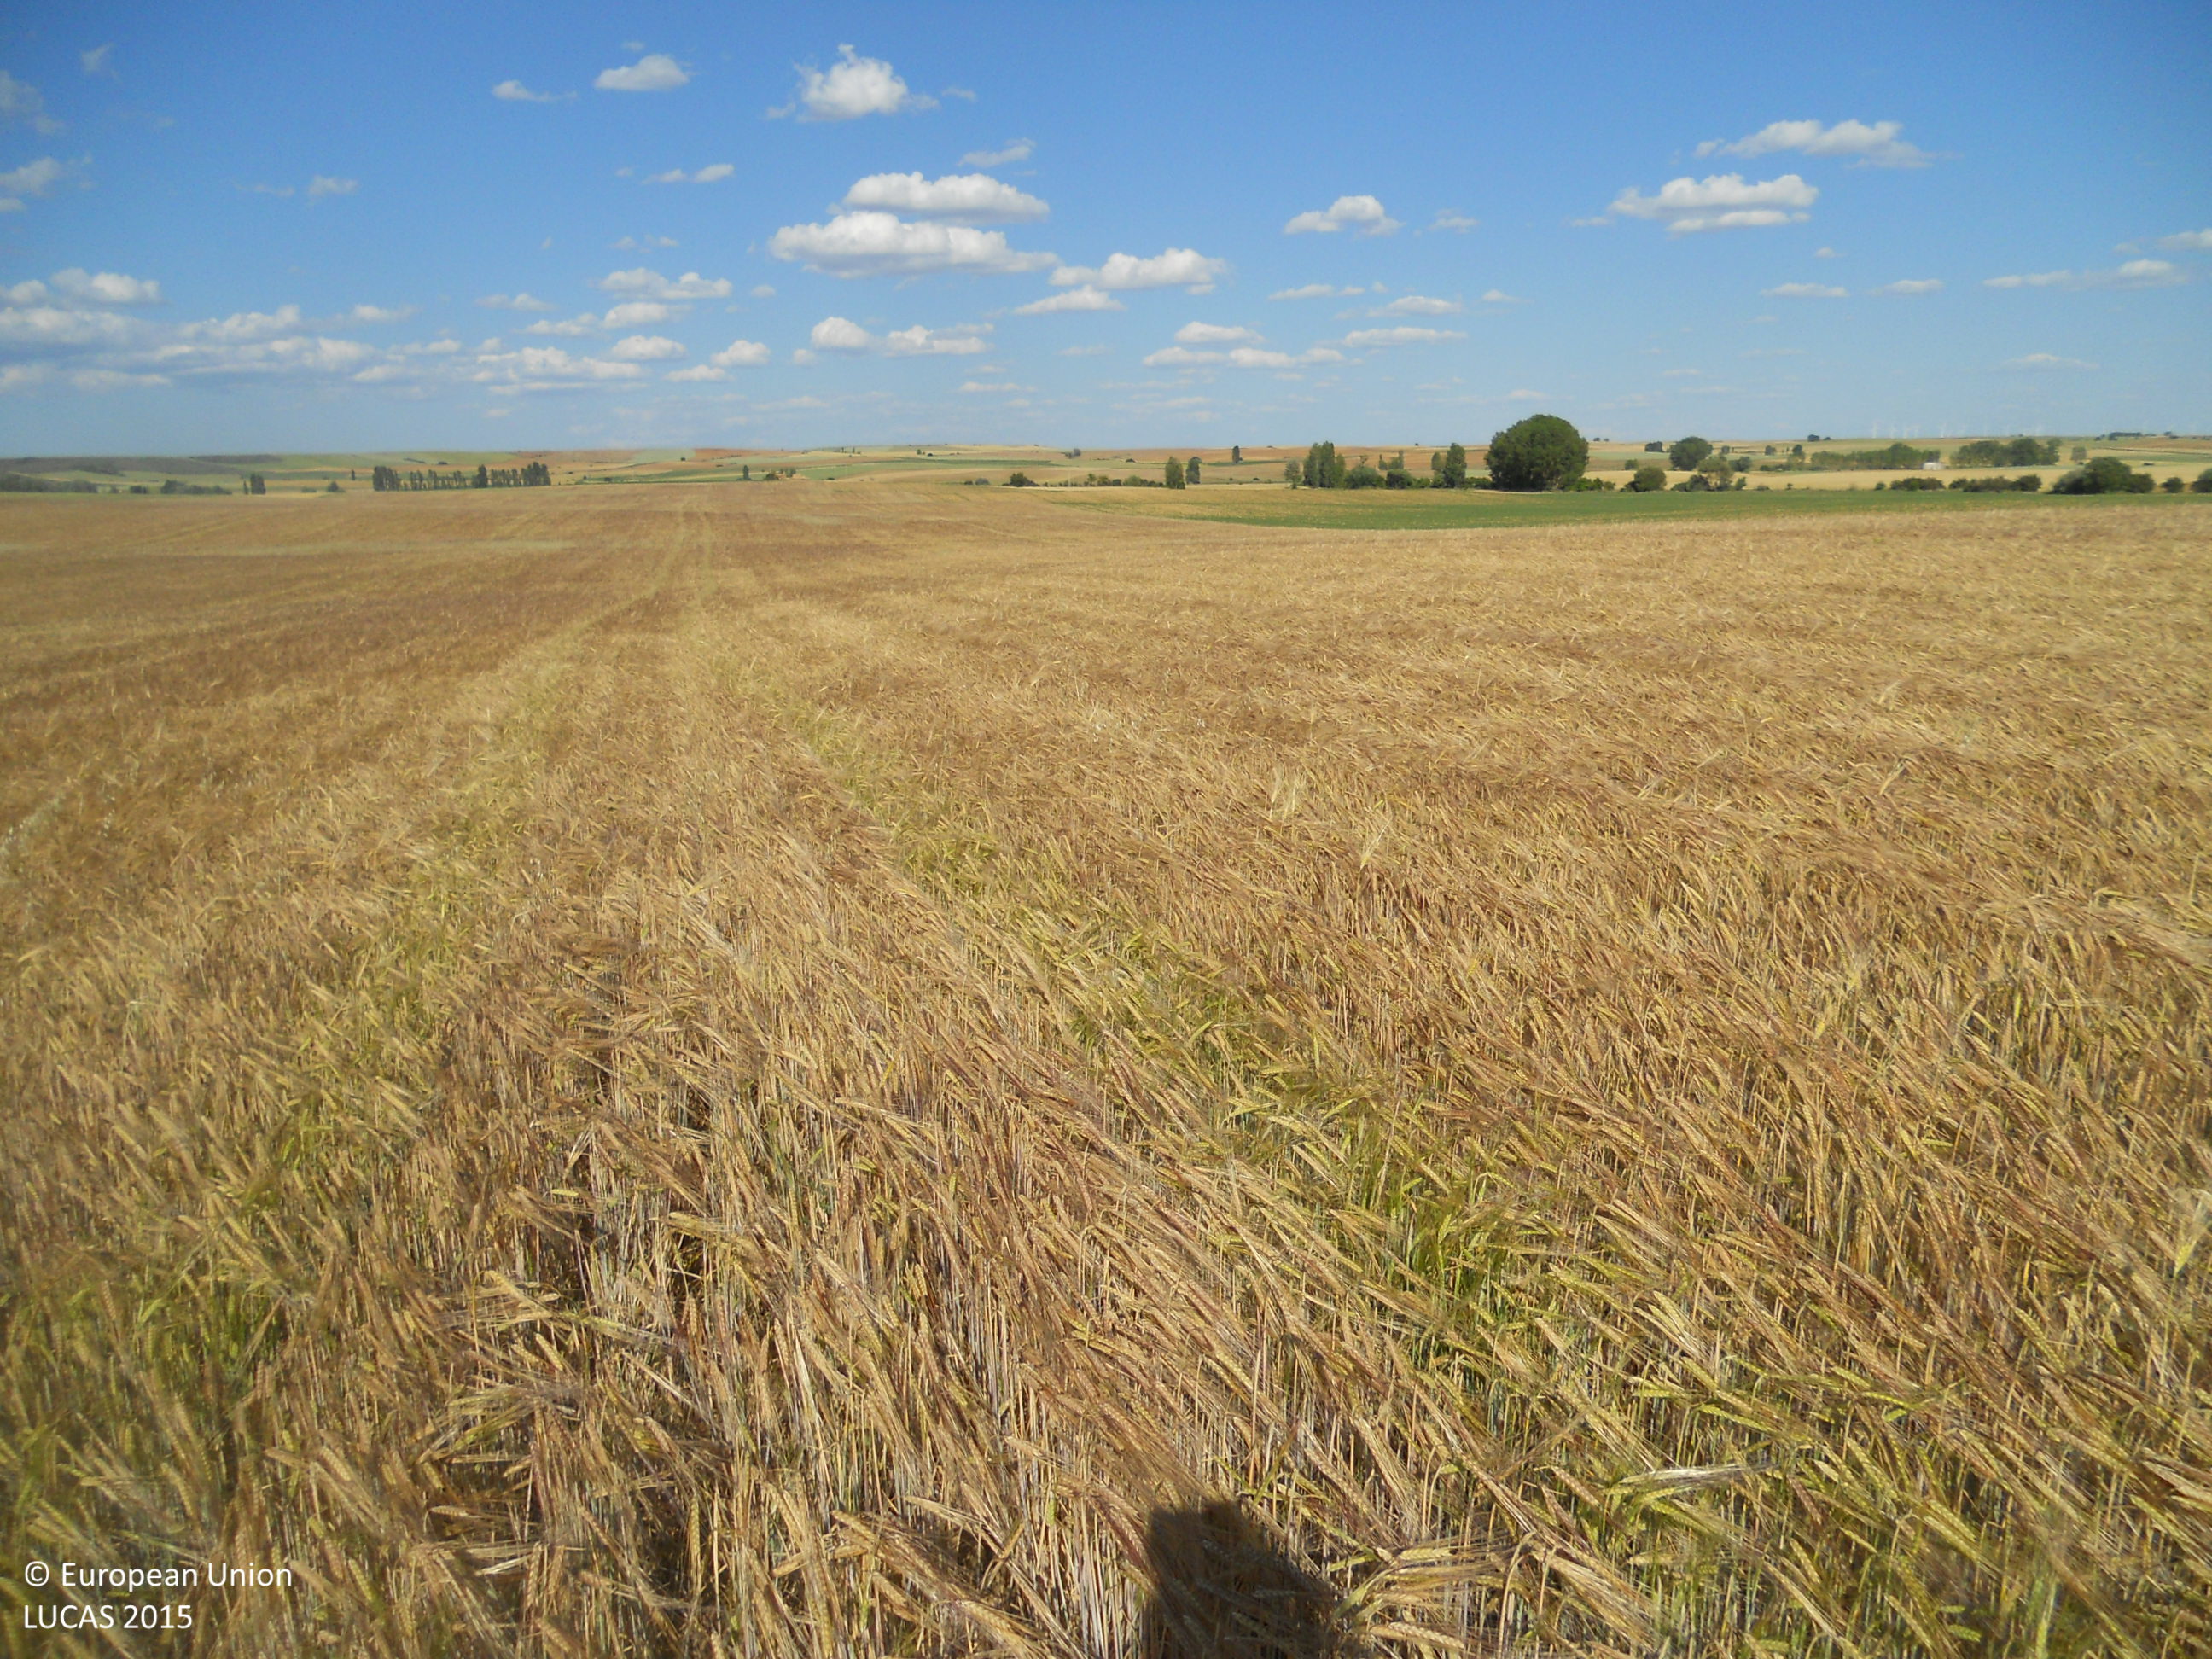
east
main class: Cropland
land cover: Barley
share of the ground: > 75 %
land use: Agriculture (excluding fallow land and kitchen gardens)
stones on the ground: < 10 %
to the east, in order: Barley; Grass margins; Sunflower
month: May
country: ES
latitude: 42.3015
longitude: -4.8664
